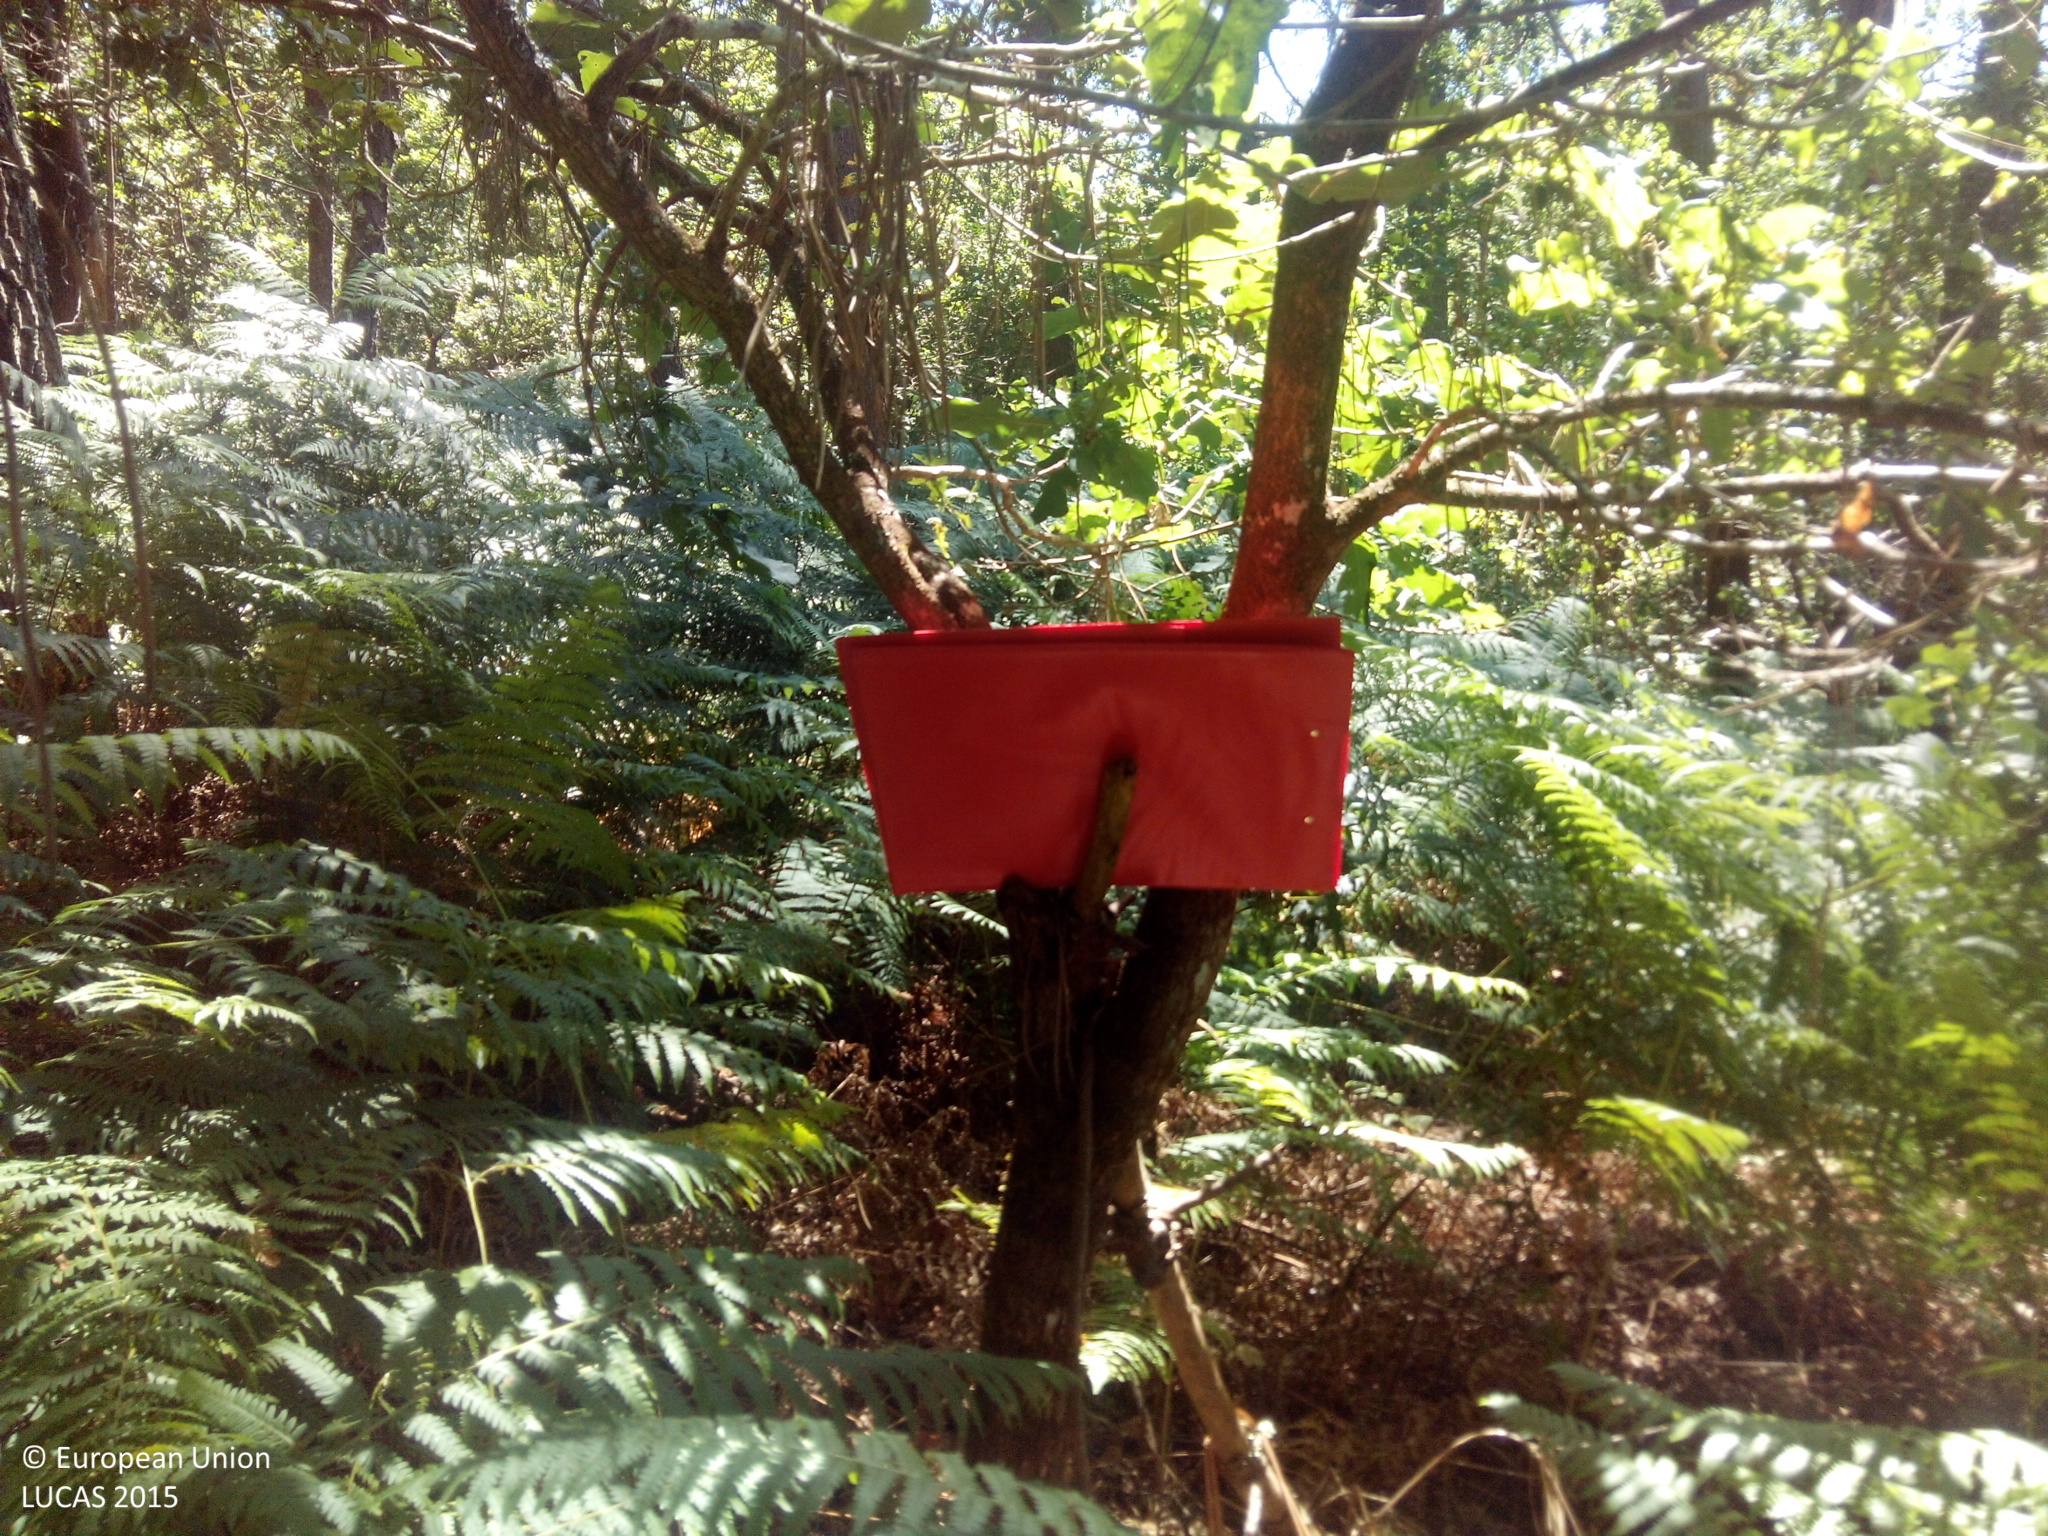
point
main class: Woodland
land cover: Pine dominated mixed woodland
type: hemiboreal forest and nemoral coniferous forest and mixed broadleaved-coniferous forest
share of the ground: > 75 %
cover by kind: coniferous forest trees 75 %, broadleaved forest trees 25 %
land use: Forestry
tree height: > 5 m
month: June
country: ES
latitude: 42.7367
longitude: -8.4337
